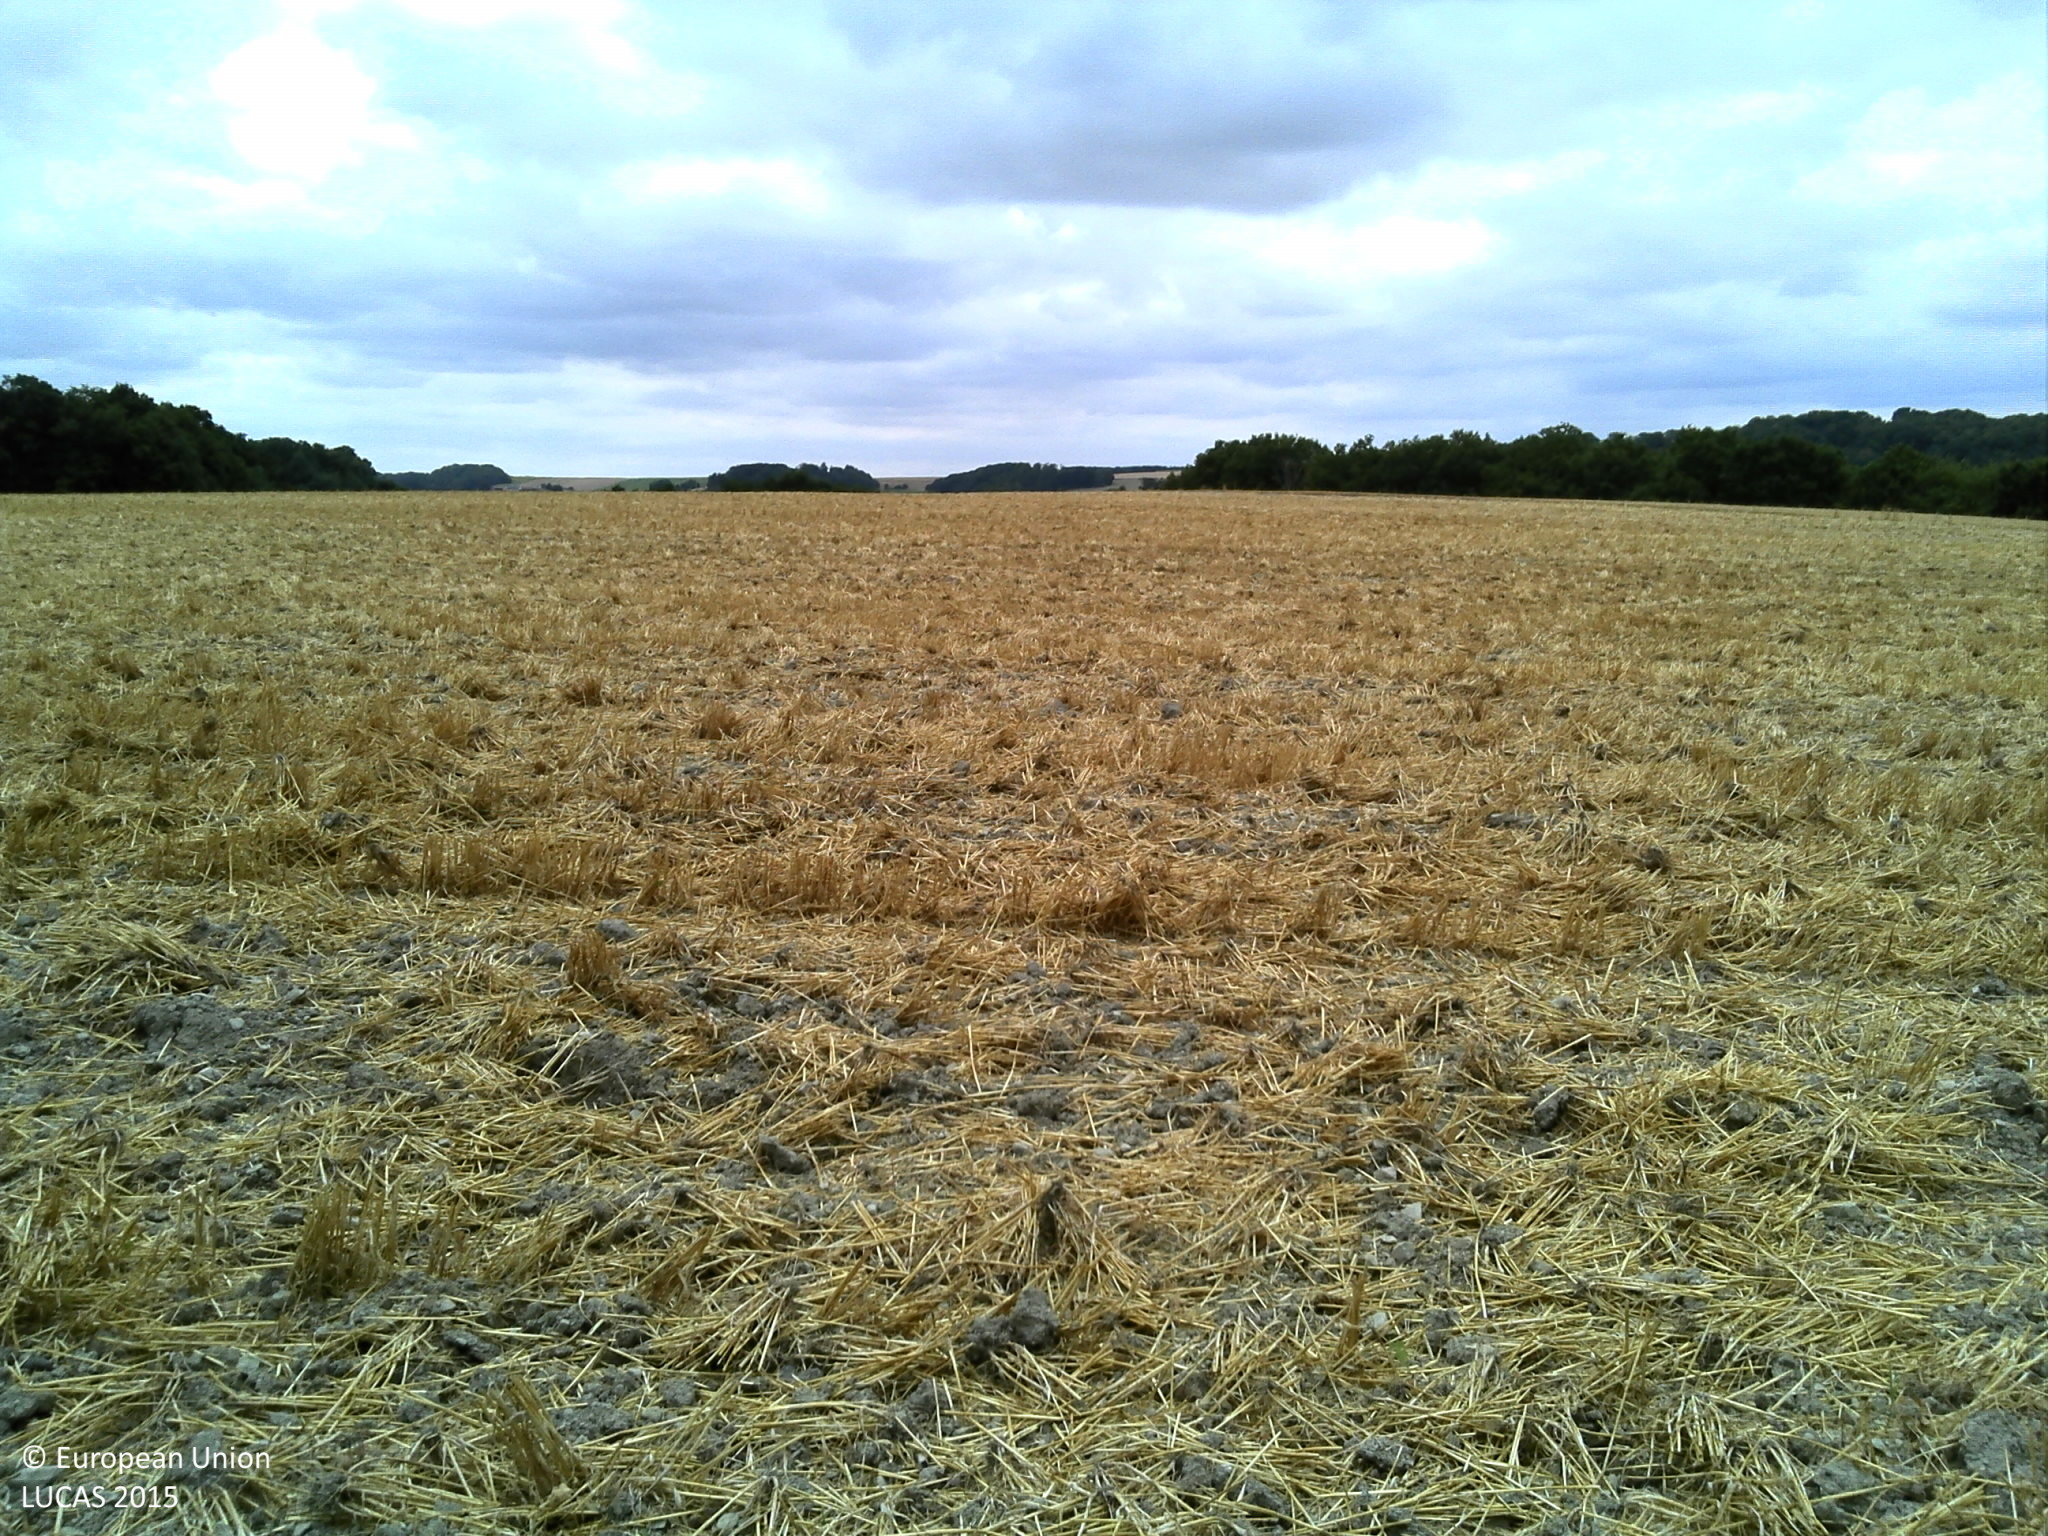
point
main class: Cropland
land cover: Barley
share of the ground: > 75 %
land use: Agriculture (excluding fallow land and kitchen gardens)
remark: Harvested field
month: July
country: FR
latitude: 49.1504
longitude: 4.8836
